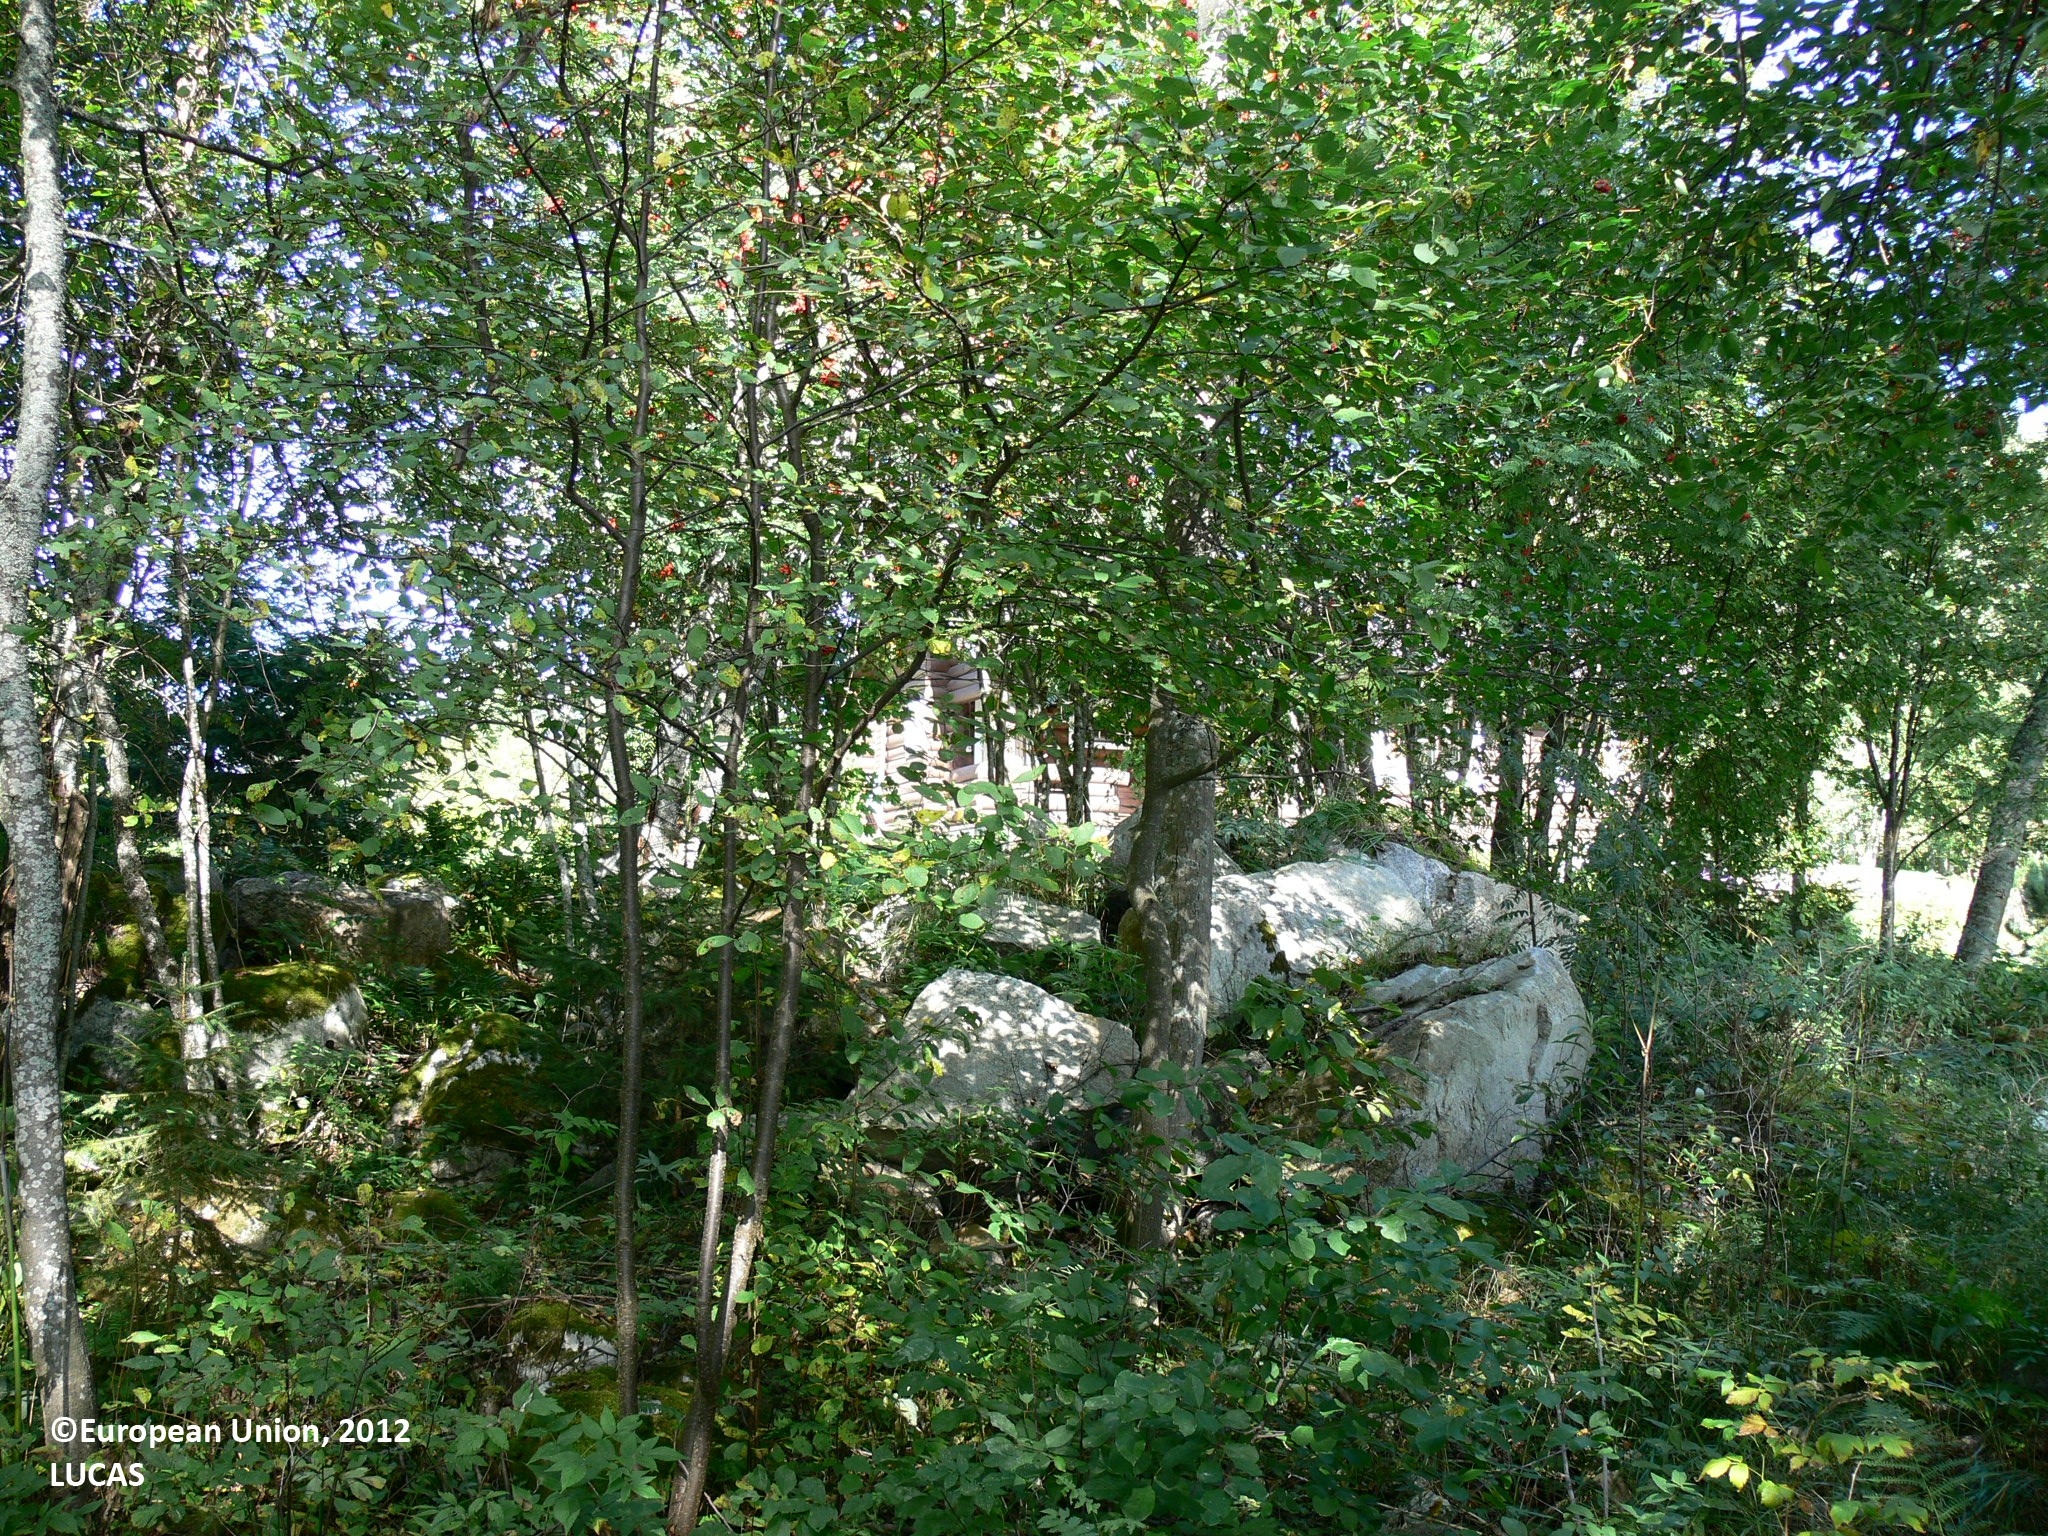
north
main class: Woodland
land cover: Broadleaved woodland
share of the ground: 50 - 75 %
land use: Forestry
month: August
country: FI
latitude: 61.9180
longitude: 30.0150
